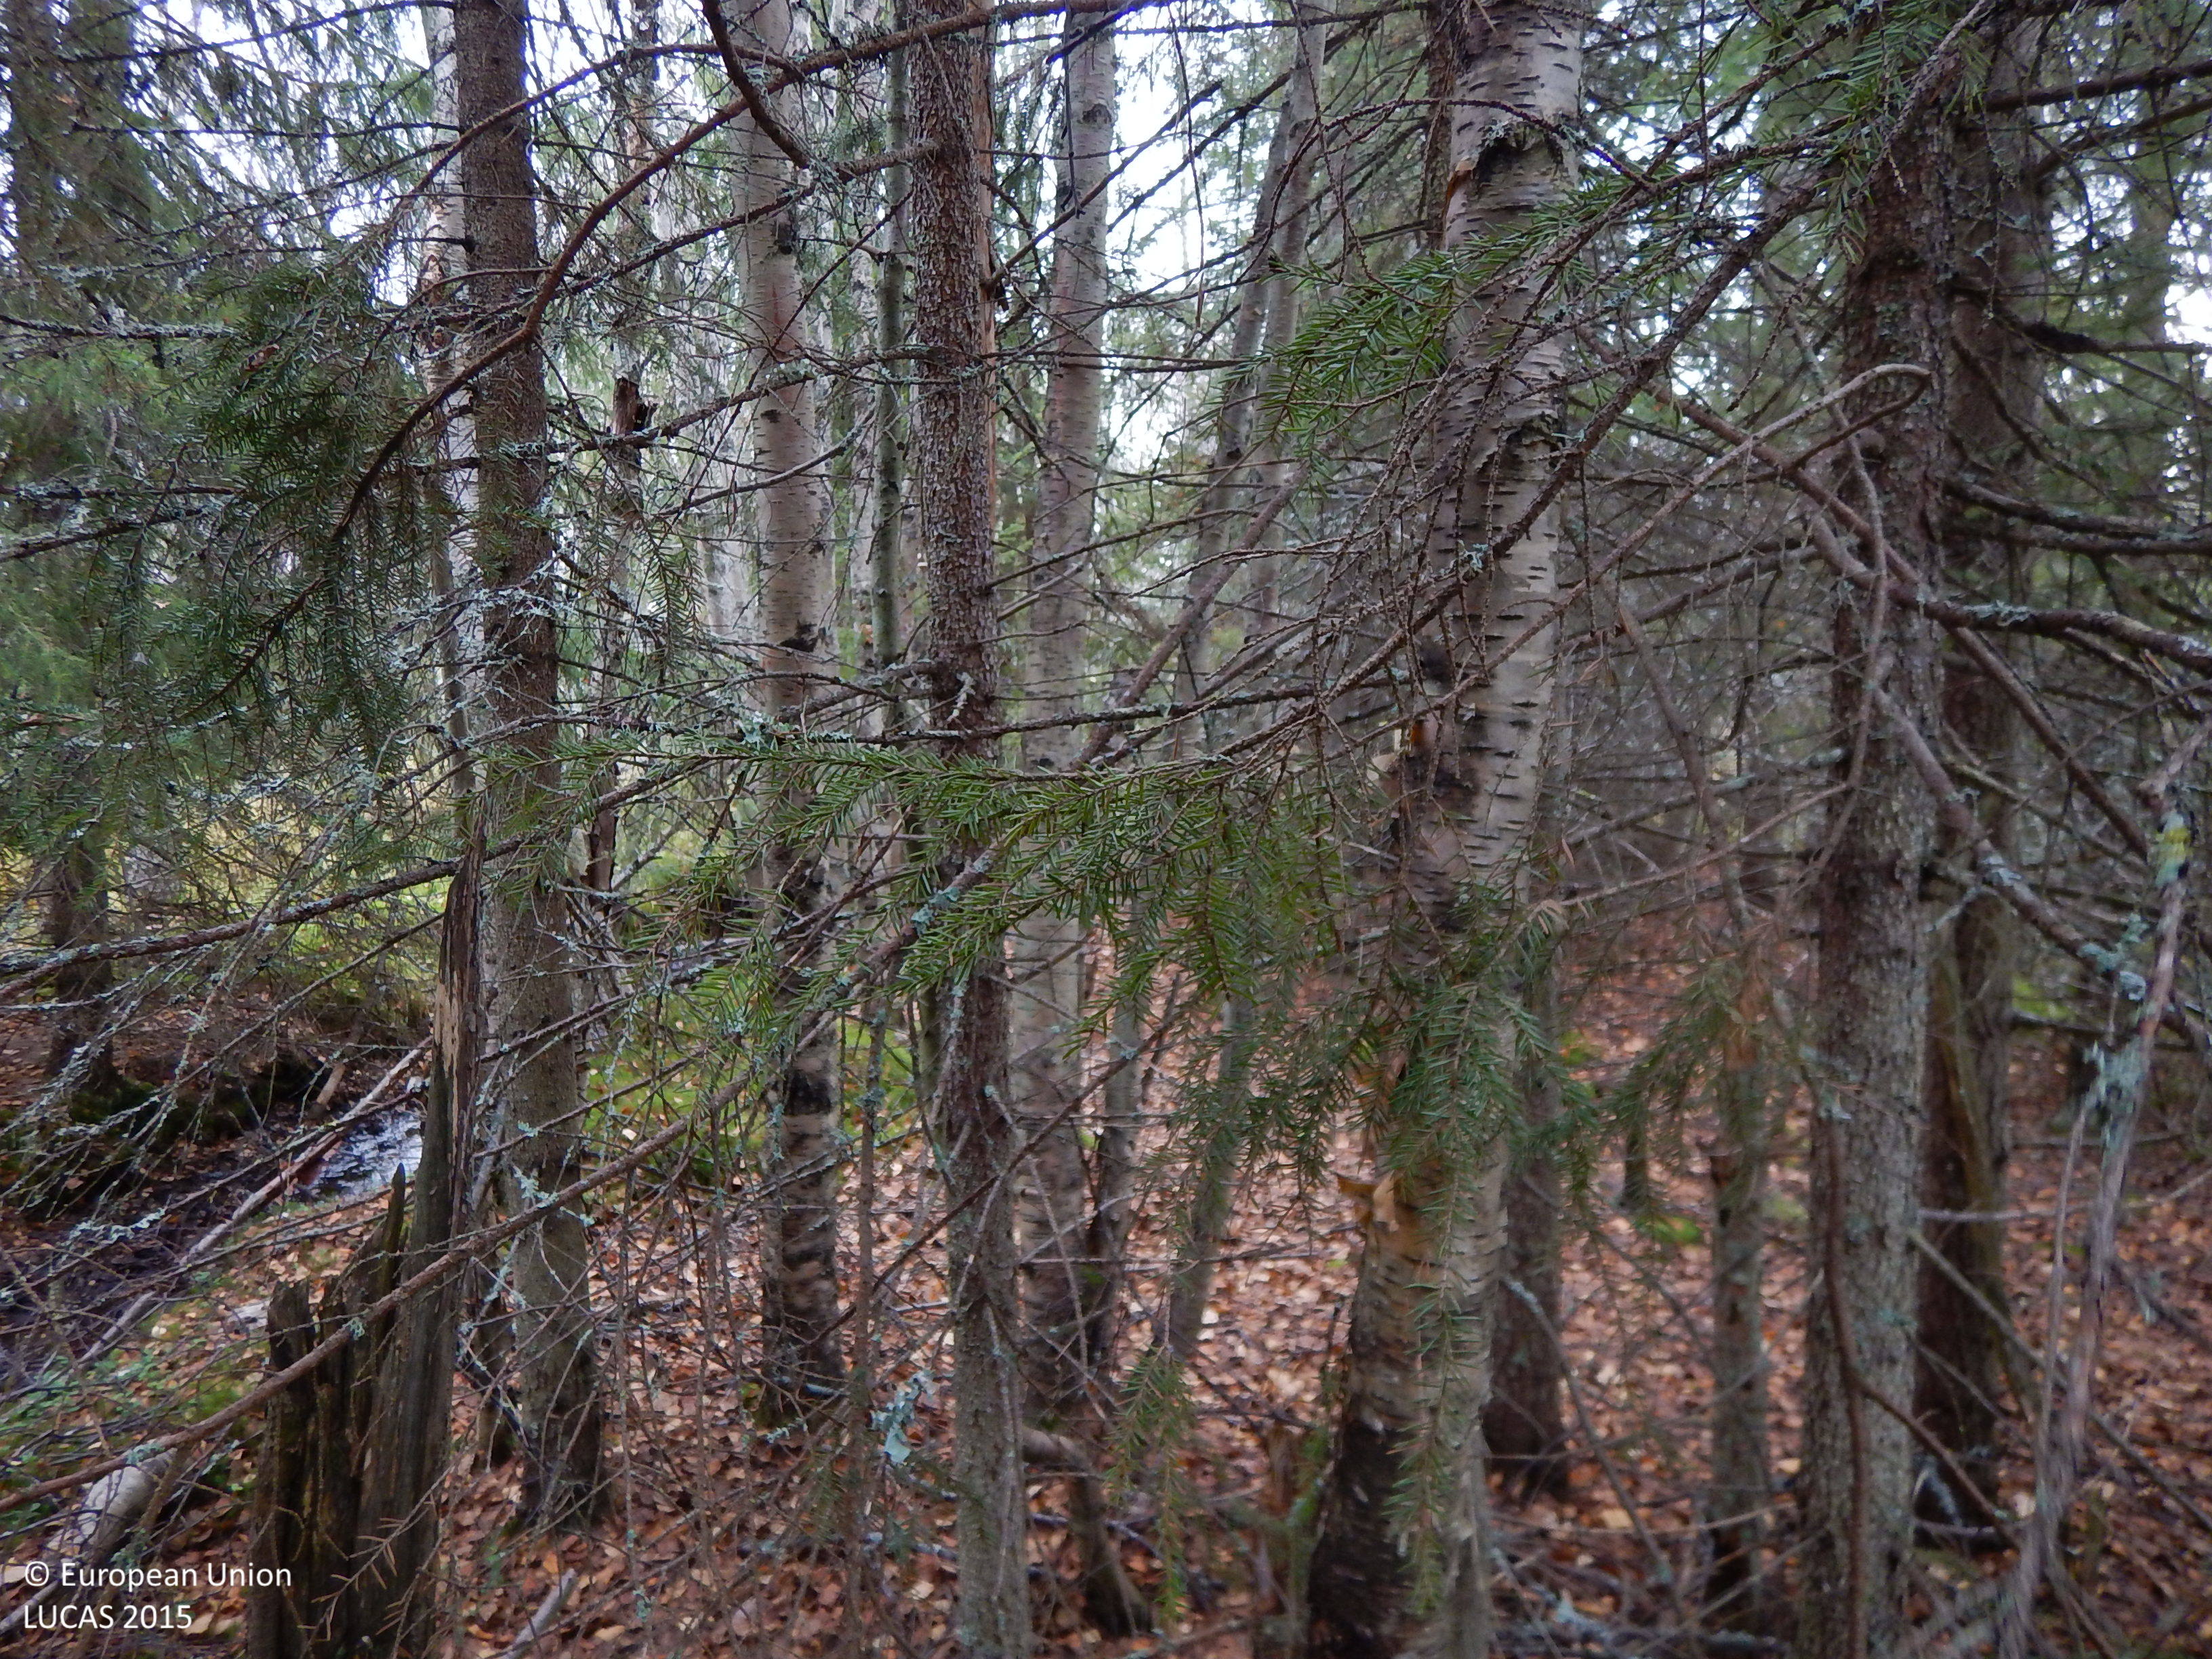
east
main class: Woodland
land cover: Spruce dominated mixed woodland
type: boreal forest
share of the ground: 50 - 75 %
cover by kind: coniferous forest trees 45 %, broadleaved forest trees 20 %, shrubs 15 %, herbaceous plants 15 %, lichens and mosses 5 %
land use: Forestry
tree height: > 5 m
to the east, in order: Spruce dominated mixed woodland; Ditches and canals; Spruce dominated mixed woodland; Other coniferous woodland; Pine dominated coniferous woodland; Pine dominated mixed woodland
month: October
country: SE
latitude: 65.1487
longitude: 21.5154
